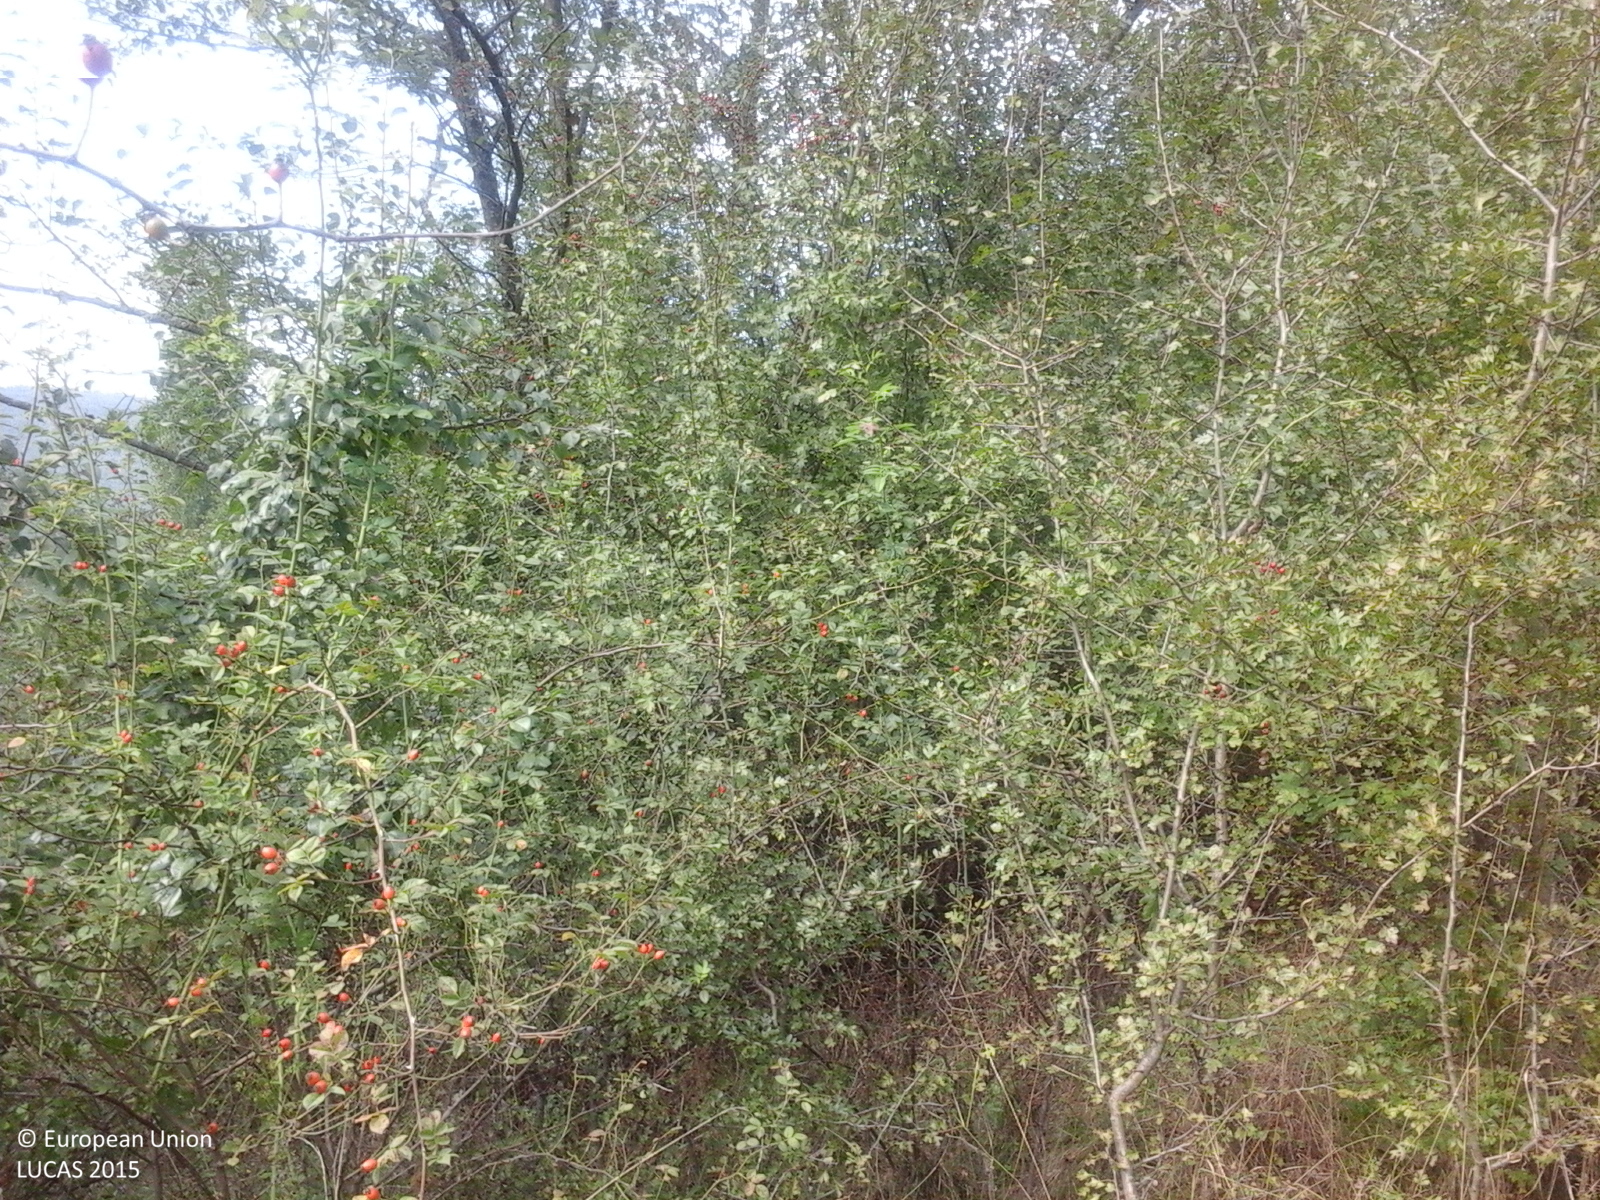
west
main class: Woodland
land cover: Broadleaved woodland
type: beech forest
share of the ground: > 75 %
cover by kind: broadleaved forest trees 100 %
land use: Forestry
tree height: < 5 m
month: September
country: RO
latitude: 47.0164
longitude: 22.9670
